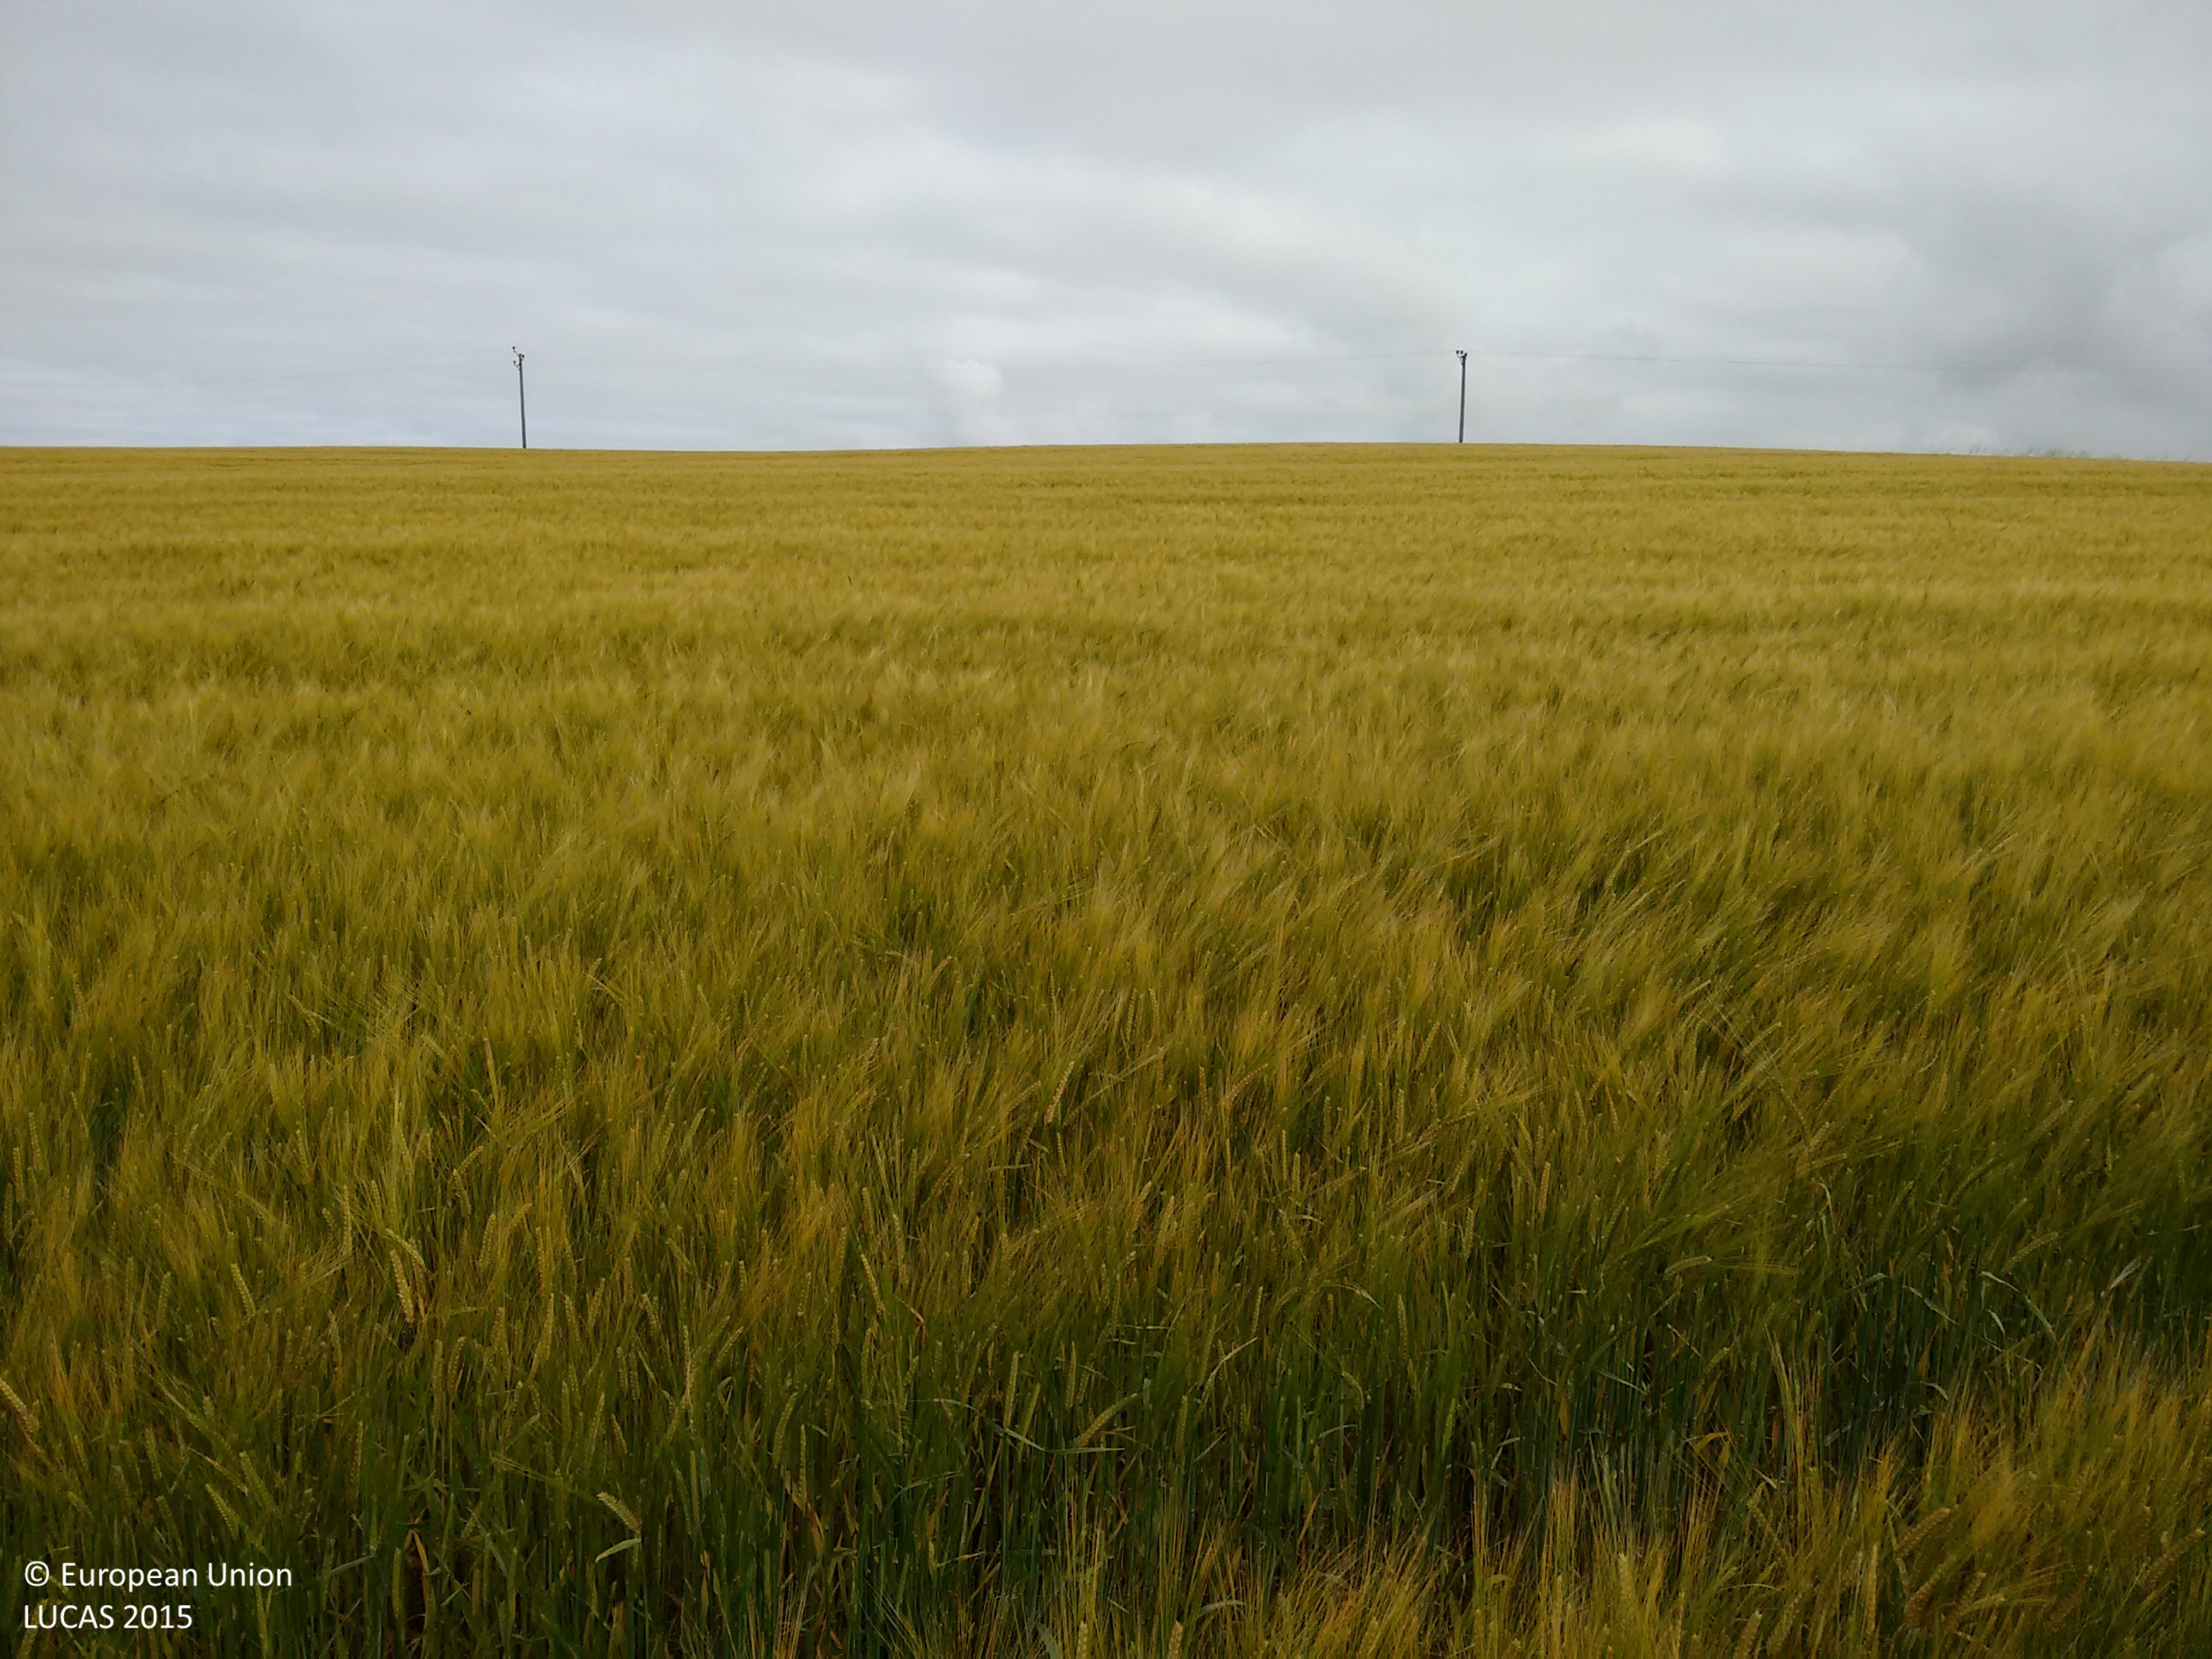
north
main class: Cropland
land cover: Barley
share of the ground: > 75 %
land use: Agriculture (excluding fallow land and kitchen gardens)
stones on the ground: 10 - 25 %
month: July
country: GB
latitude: 57.5513
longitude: -2.4001
